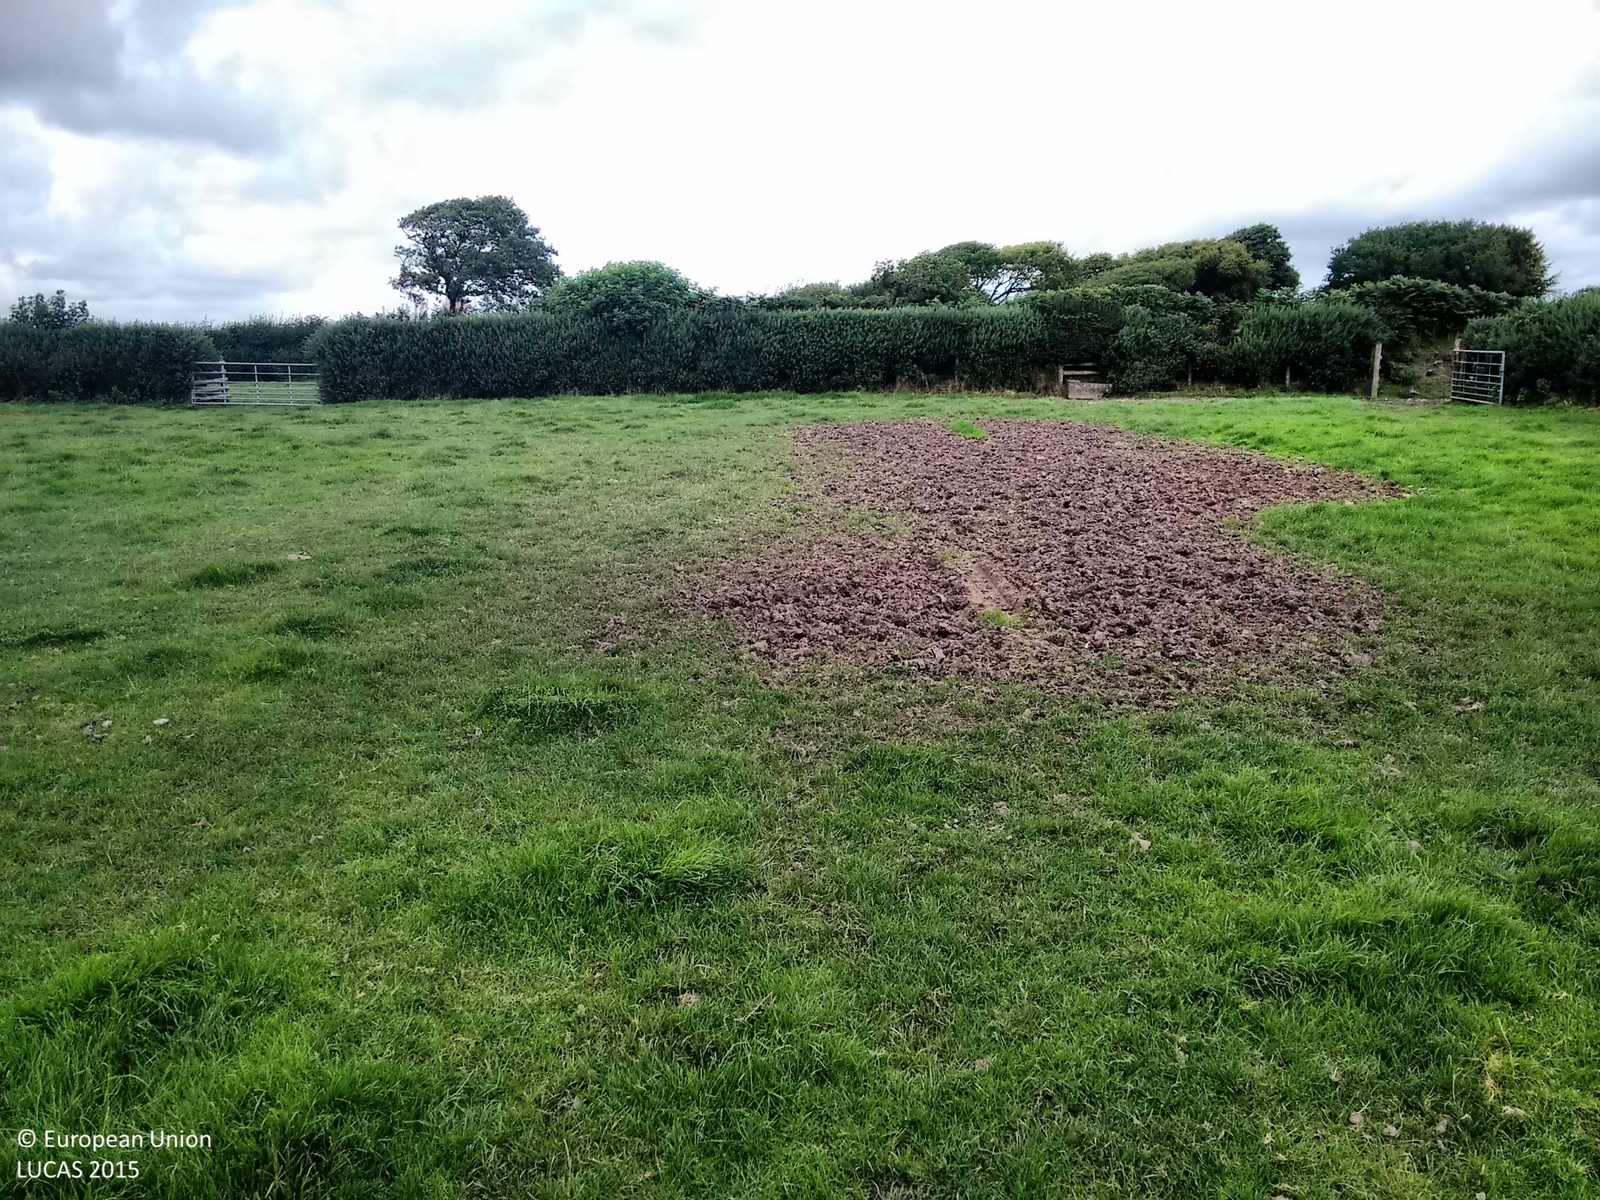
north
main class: Grassland
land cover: Grassland without tree/shrub cover
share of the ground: > 75 %
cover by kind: herbaceous plants 100 %
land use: Agriculture (excluding fallow land and kitchen gardens)
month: September
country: GB
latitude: 50.5925
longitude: -4.4411
